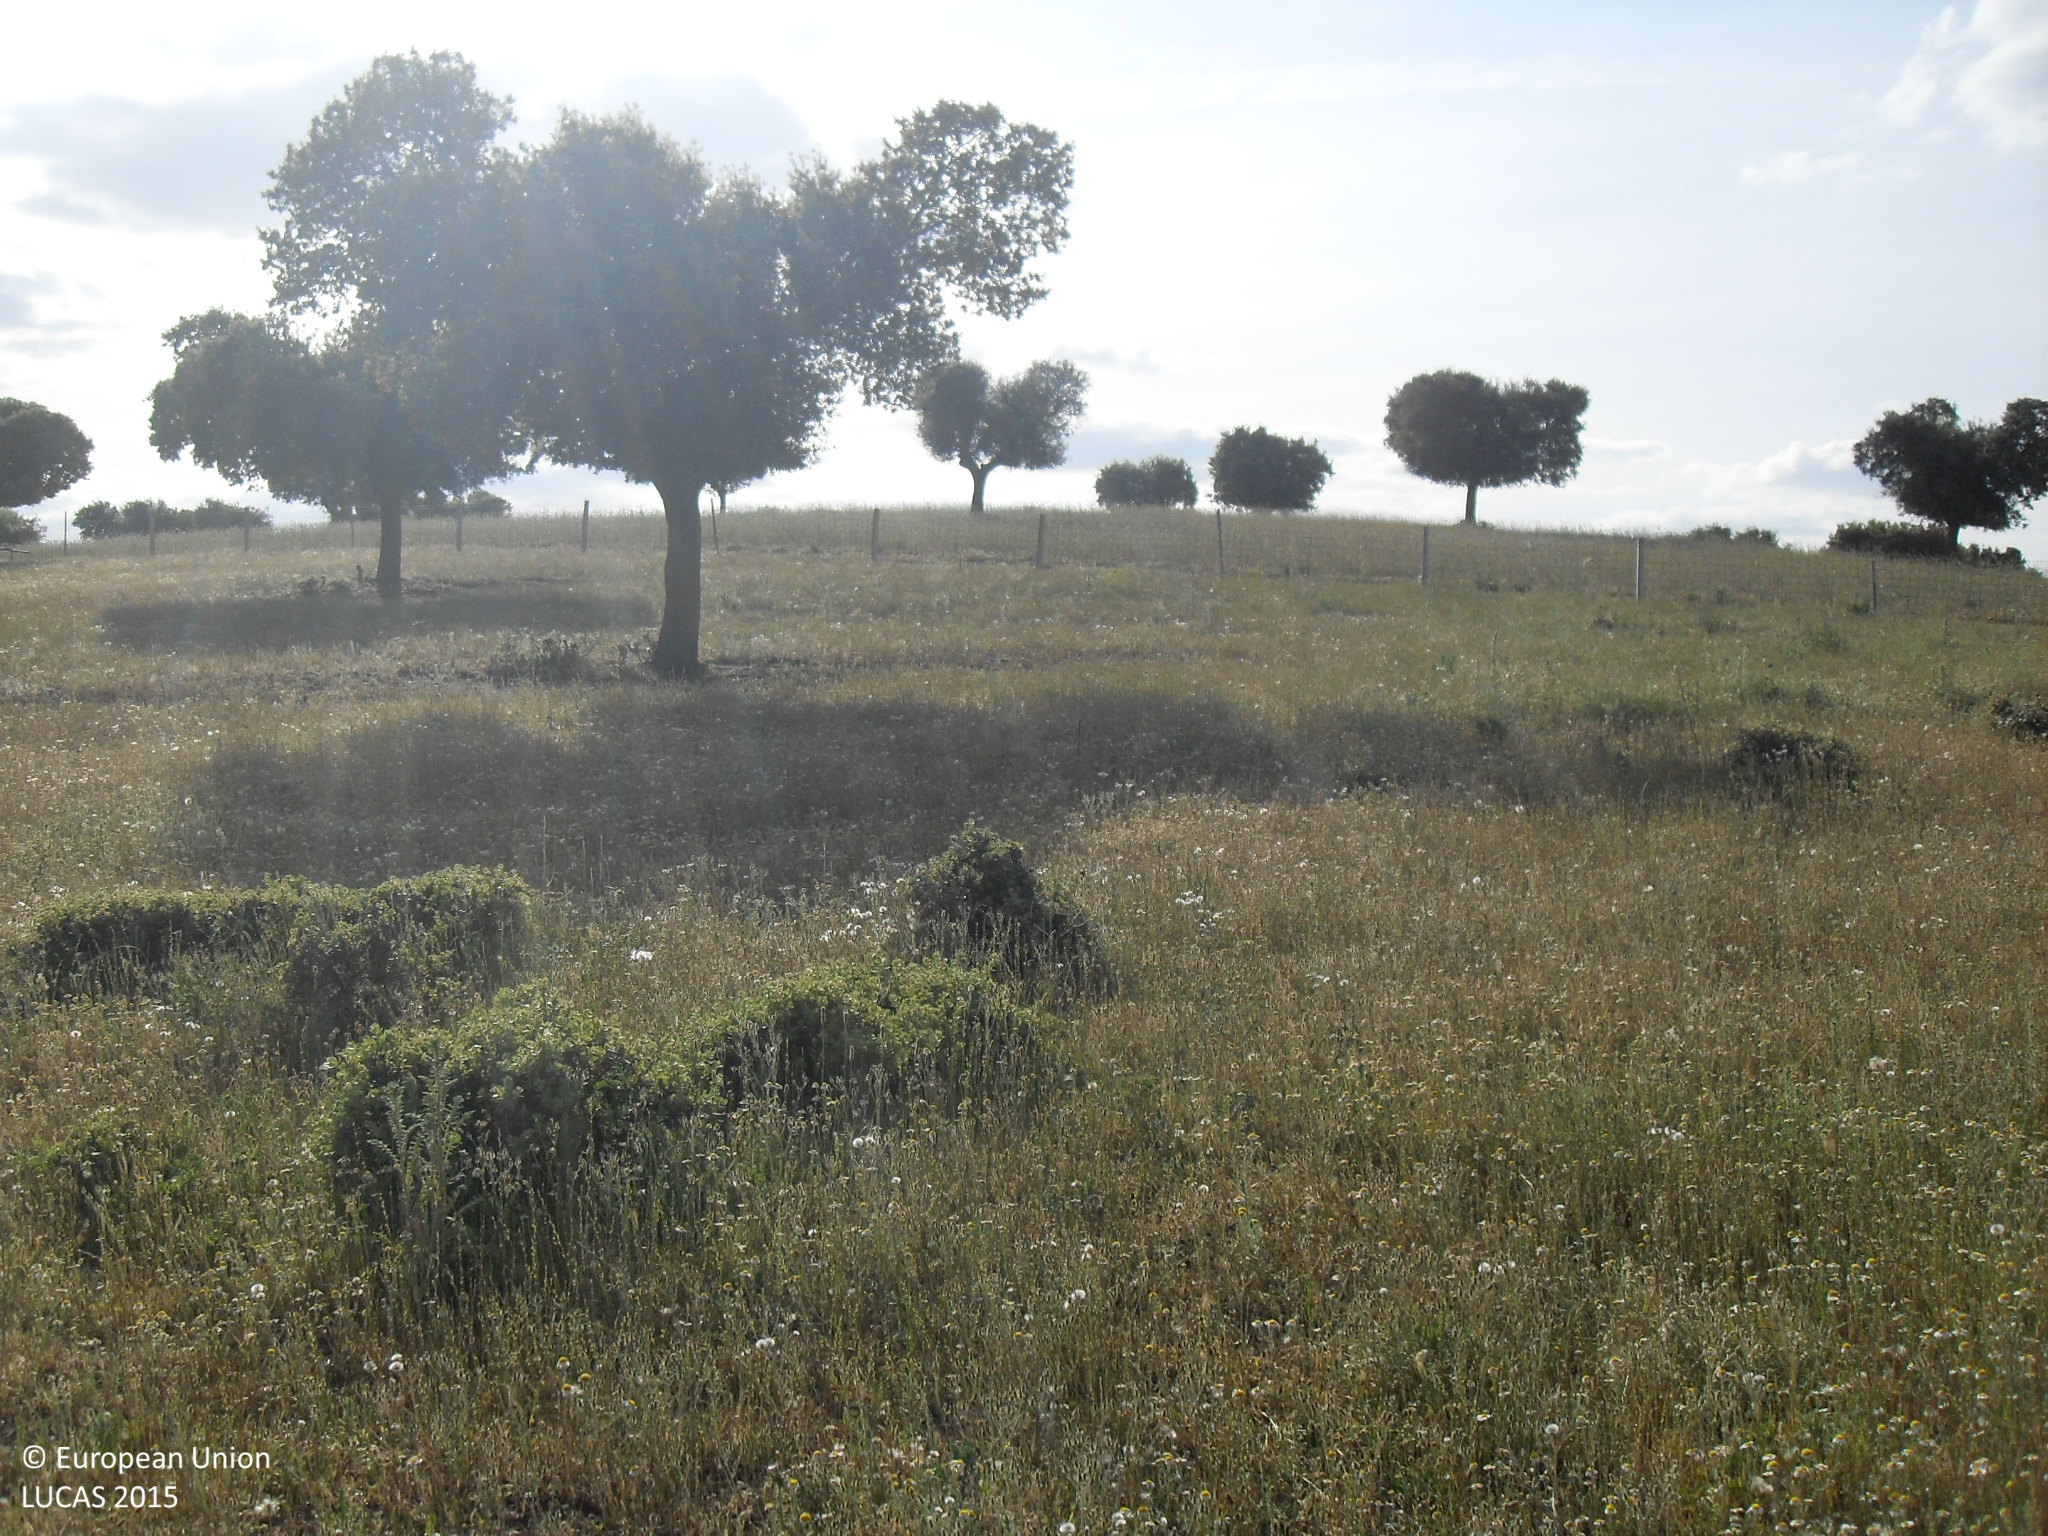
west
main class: Woodland
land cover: Broadleaved woodland
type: broadleaved evergreen forest
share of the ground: 10 - 25 %
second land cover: Grassland without tree/shrub cover
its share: > 75 %
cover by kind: herbaceous plants 80 %, broadleaved forest trees 20 %
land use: Forestry
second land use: Agriculture (excluding fallow land and kitchen gardens)
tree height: < 5 m
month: May
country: ES
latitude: 40.9927
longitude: -5.7344
